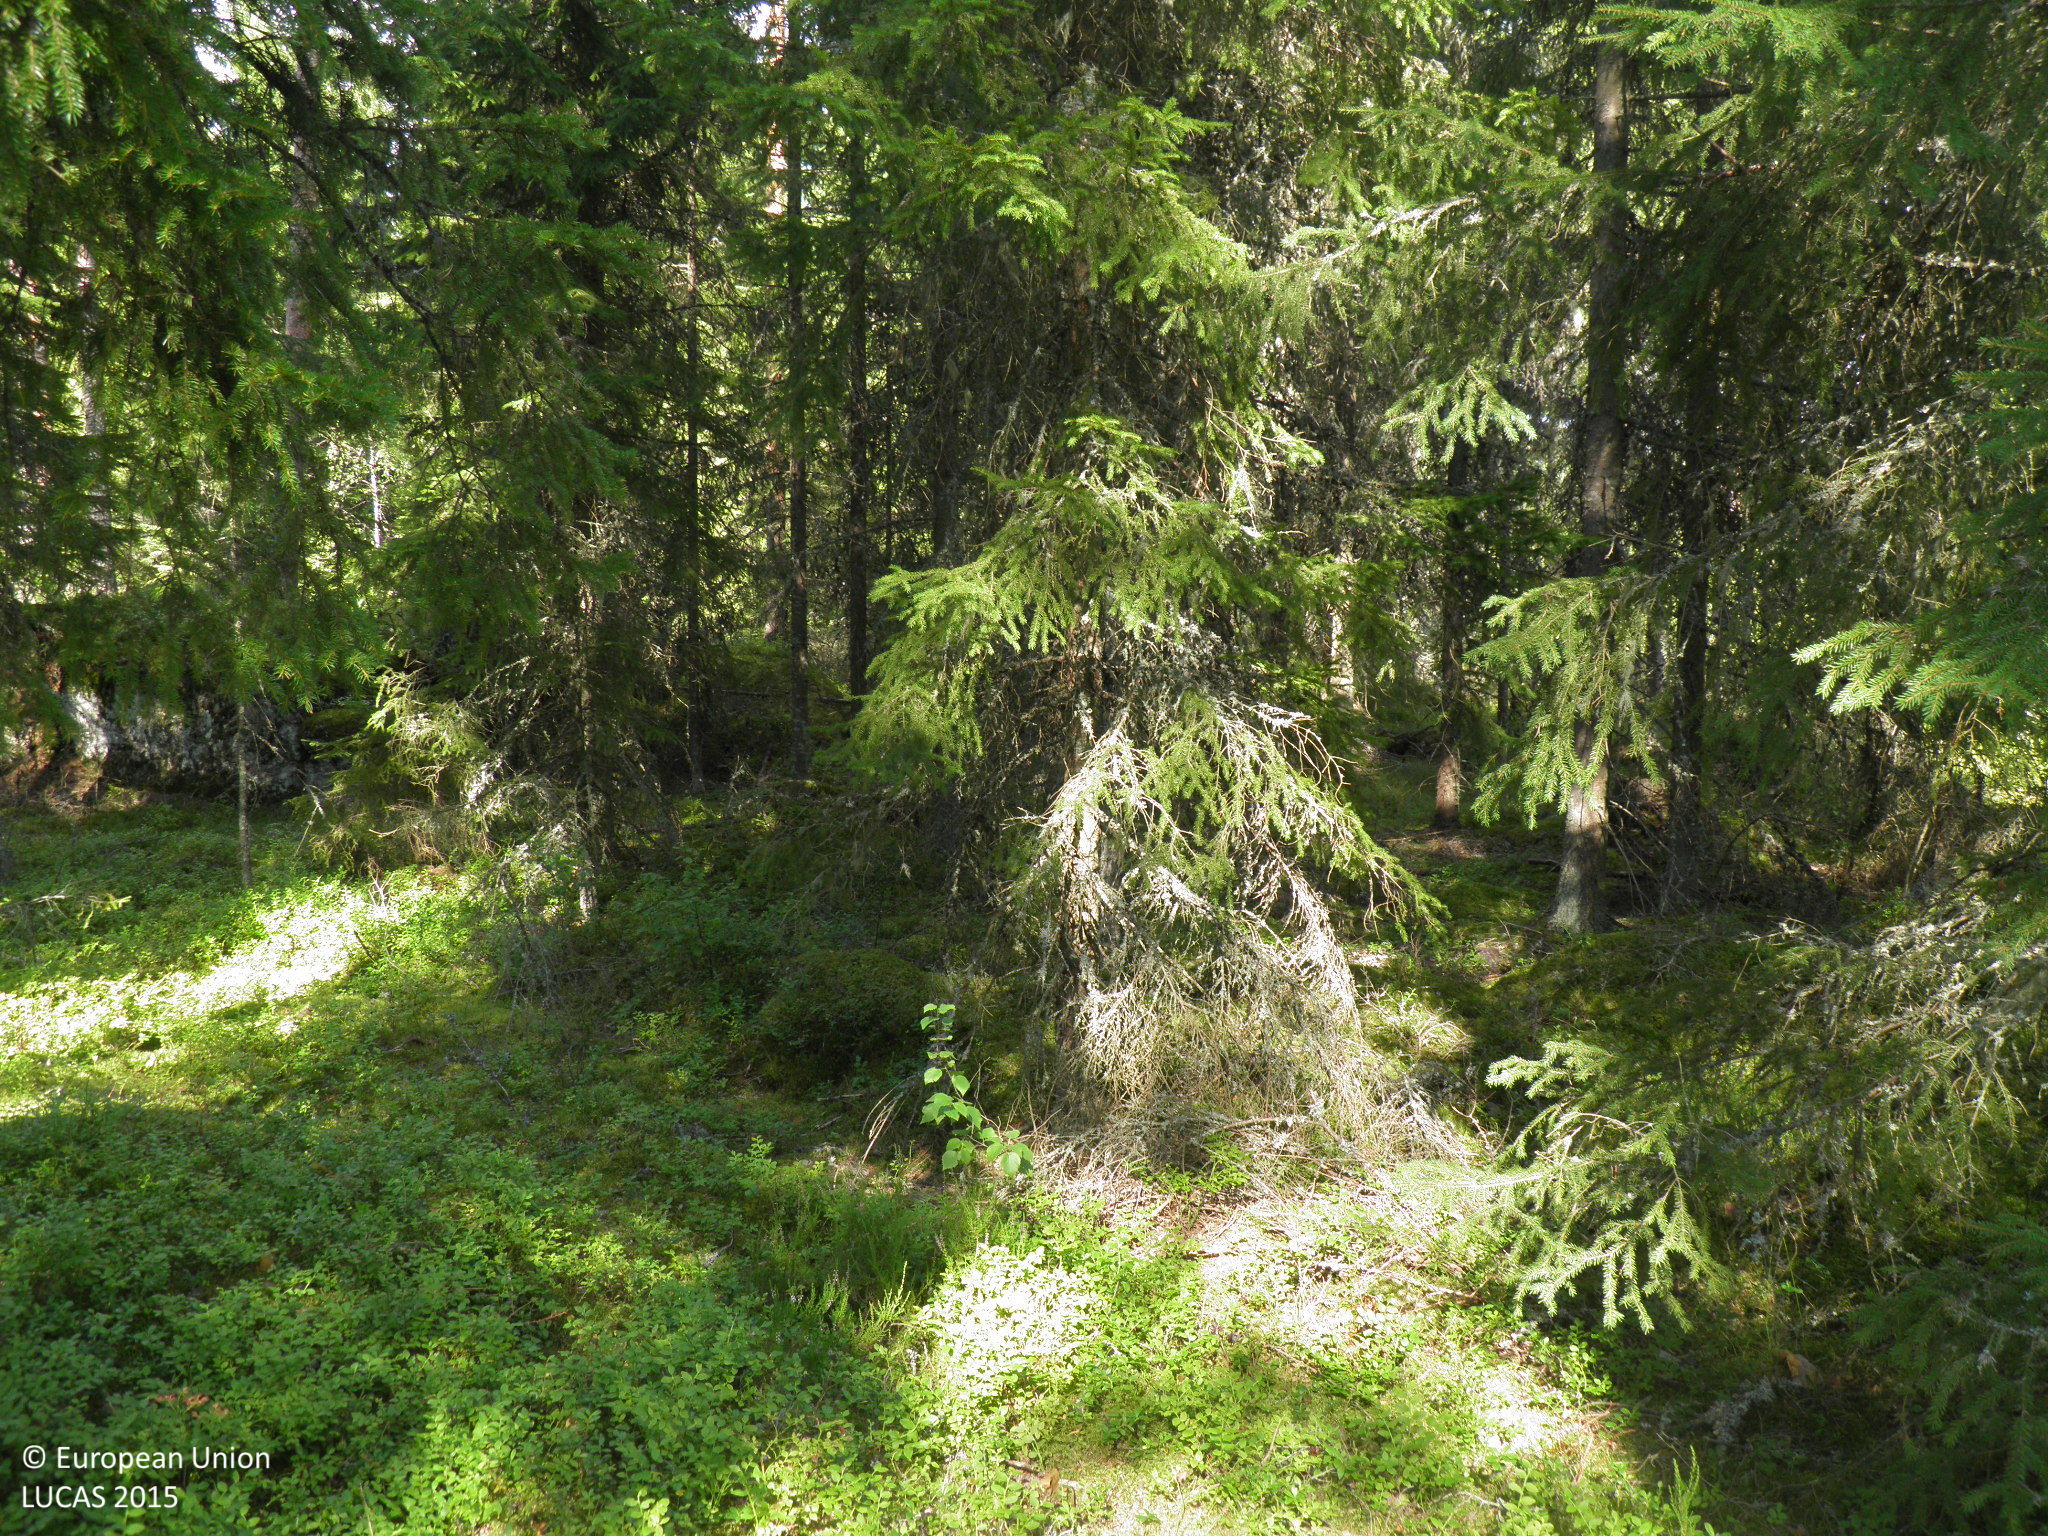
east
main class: Woodland
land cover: Spruce dominated coniferous woodland
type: hemiboreal forest and nemoral coniferous forest and mixed broadleaved-coniferous forest
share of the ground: 50 - 75 %
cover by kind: coniferous forest trees 70 %, shrubs 15 %, lichens and mosses 15 %
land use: Forestry
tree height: > 5 m
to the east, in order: Spruce dominated coniferous woodland; Ditches and canals; Broadleaved woodland; Ditches and canals; Pine dominated mixed woodland; Ditches and canals; Pine dominated mixed woodland; Pine dominated coniferous woodland
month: August
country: FI
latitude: 61.0291
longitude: 21.8472
